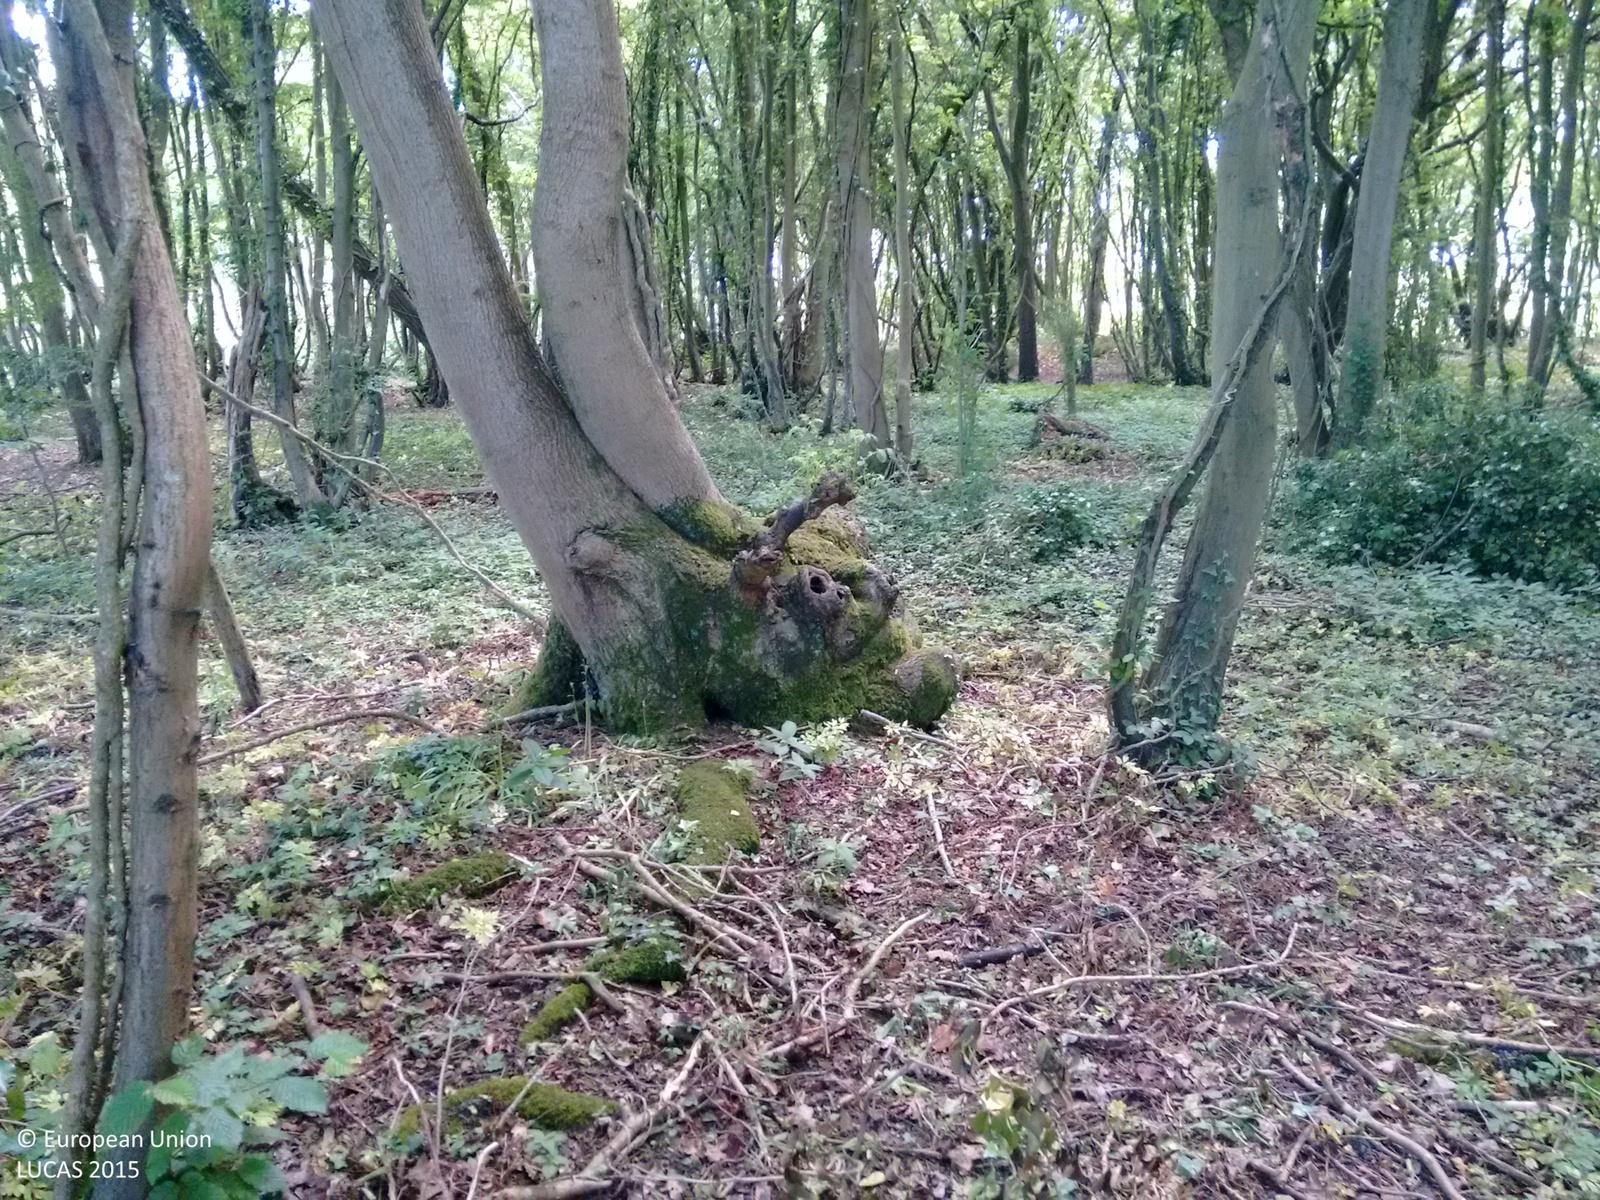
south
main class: Woodland
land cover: Broadleaved woodland
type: mesophytic deciduous forest
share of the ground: > 75 %
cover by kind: broadleaved forest trees 100 %
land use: Semi-natural and natural areas not in use
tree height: > 5 m
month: June
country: GB
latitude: 50.9376
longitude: 0.6238
